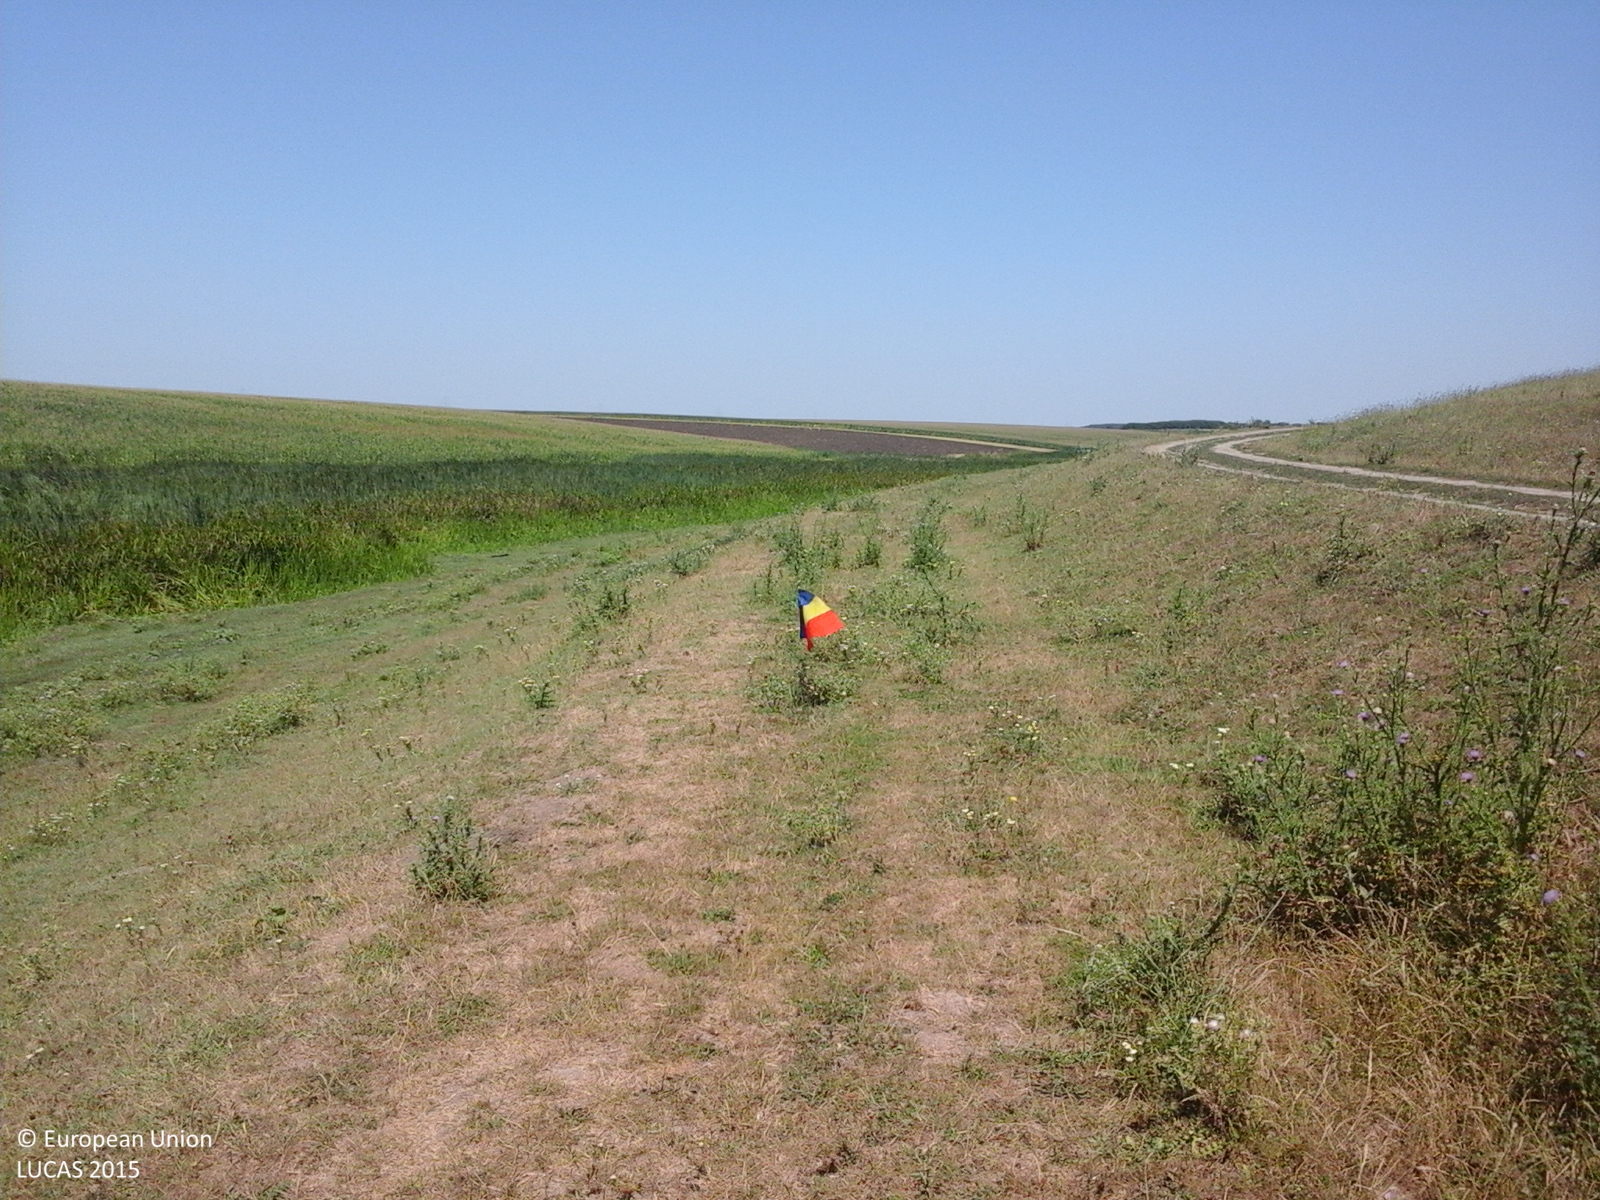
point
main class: Grassland
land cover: Grassland without tree/shrub cover
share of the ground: > 75 %
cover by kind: herbaceous plants 100 %
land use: Agriculture (excluding fallow land and kitchen gardens)
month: July
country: RO
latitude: 44.3853
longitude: 26.5725
